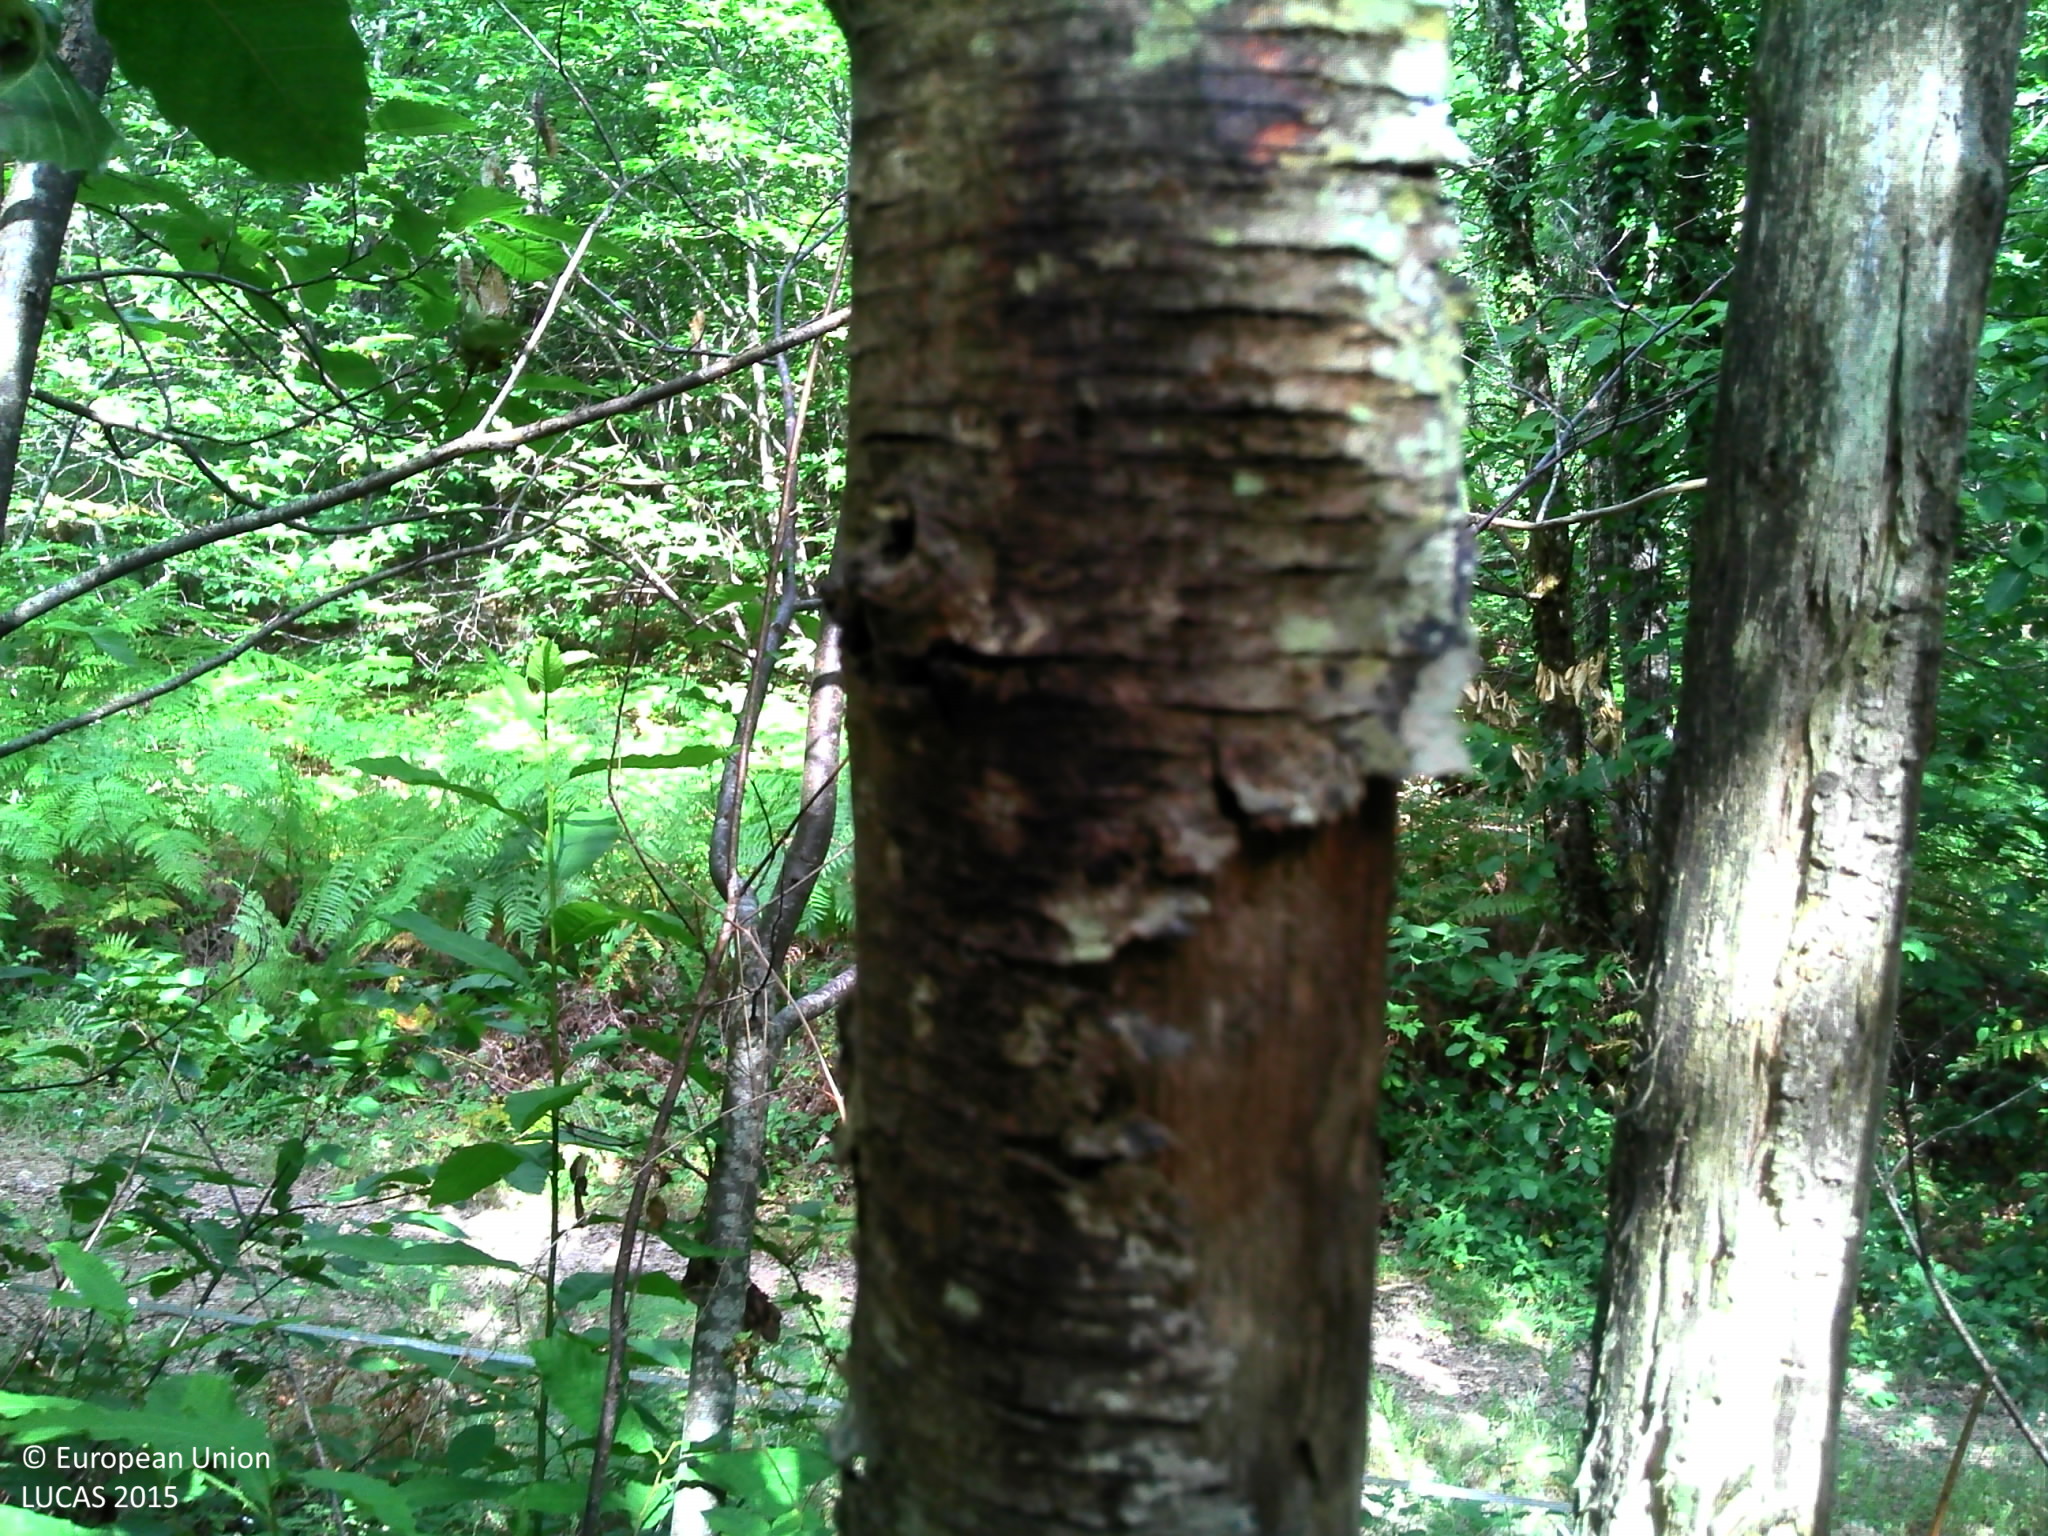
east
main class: Woodland
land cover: Broadleaved woodland
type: thermophilous deciduous forest
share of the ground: > 75 %
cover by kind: broadleaved forest trees 80 %, shrubs 10 %, herbaceous plants 10 %
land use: Forestry
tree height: > 5 m
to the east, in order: Broadleaved woodland; Fences; Tracks; Broadleaved woodland; Artificial constructions in urban areas; Broadleaved woodland; Fences; Grassland without tree/shrub cover
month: July
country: FR
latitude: 45.0933
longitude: 0.7020
